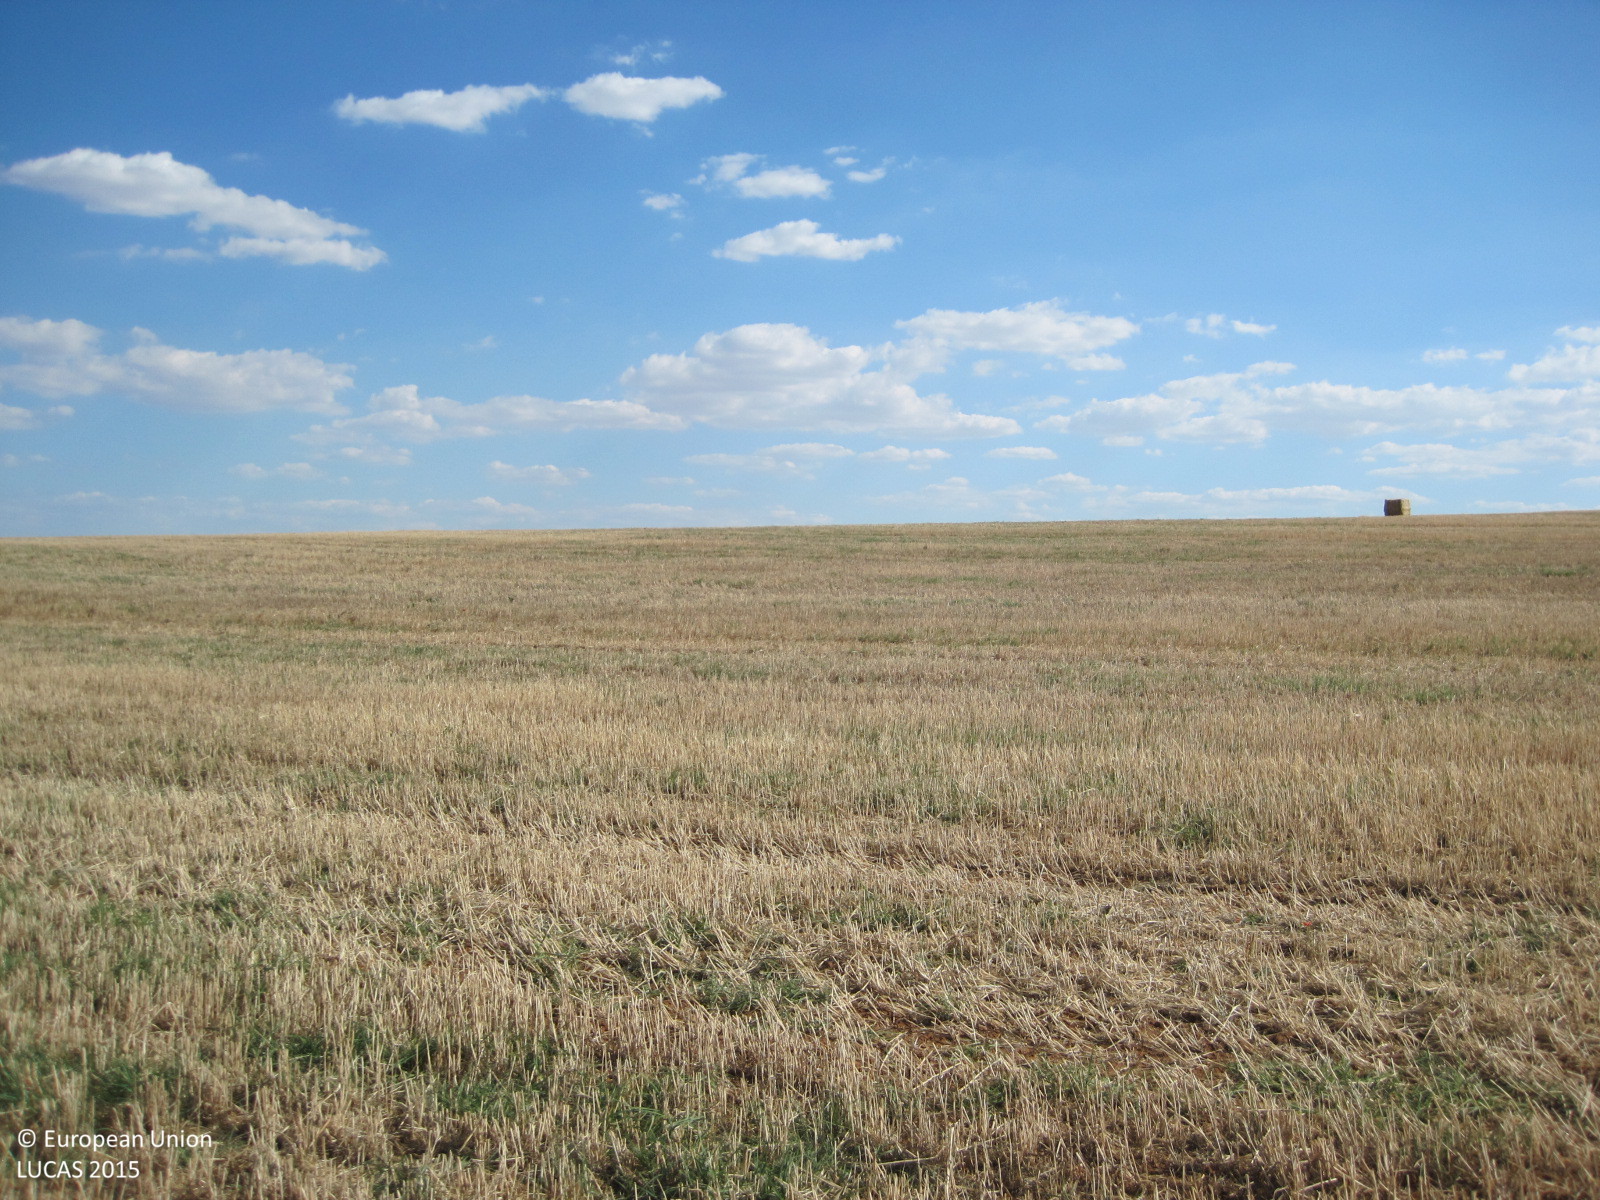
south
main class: Cropland
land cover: Barley
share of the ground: < 10 %
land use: Agriculture (excluding fallow land and kitchen gardens)
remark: Harvested field
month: June
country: ES
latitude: 39.9245
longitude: -4.2070
